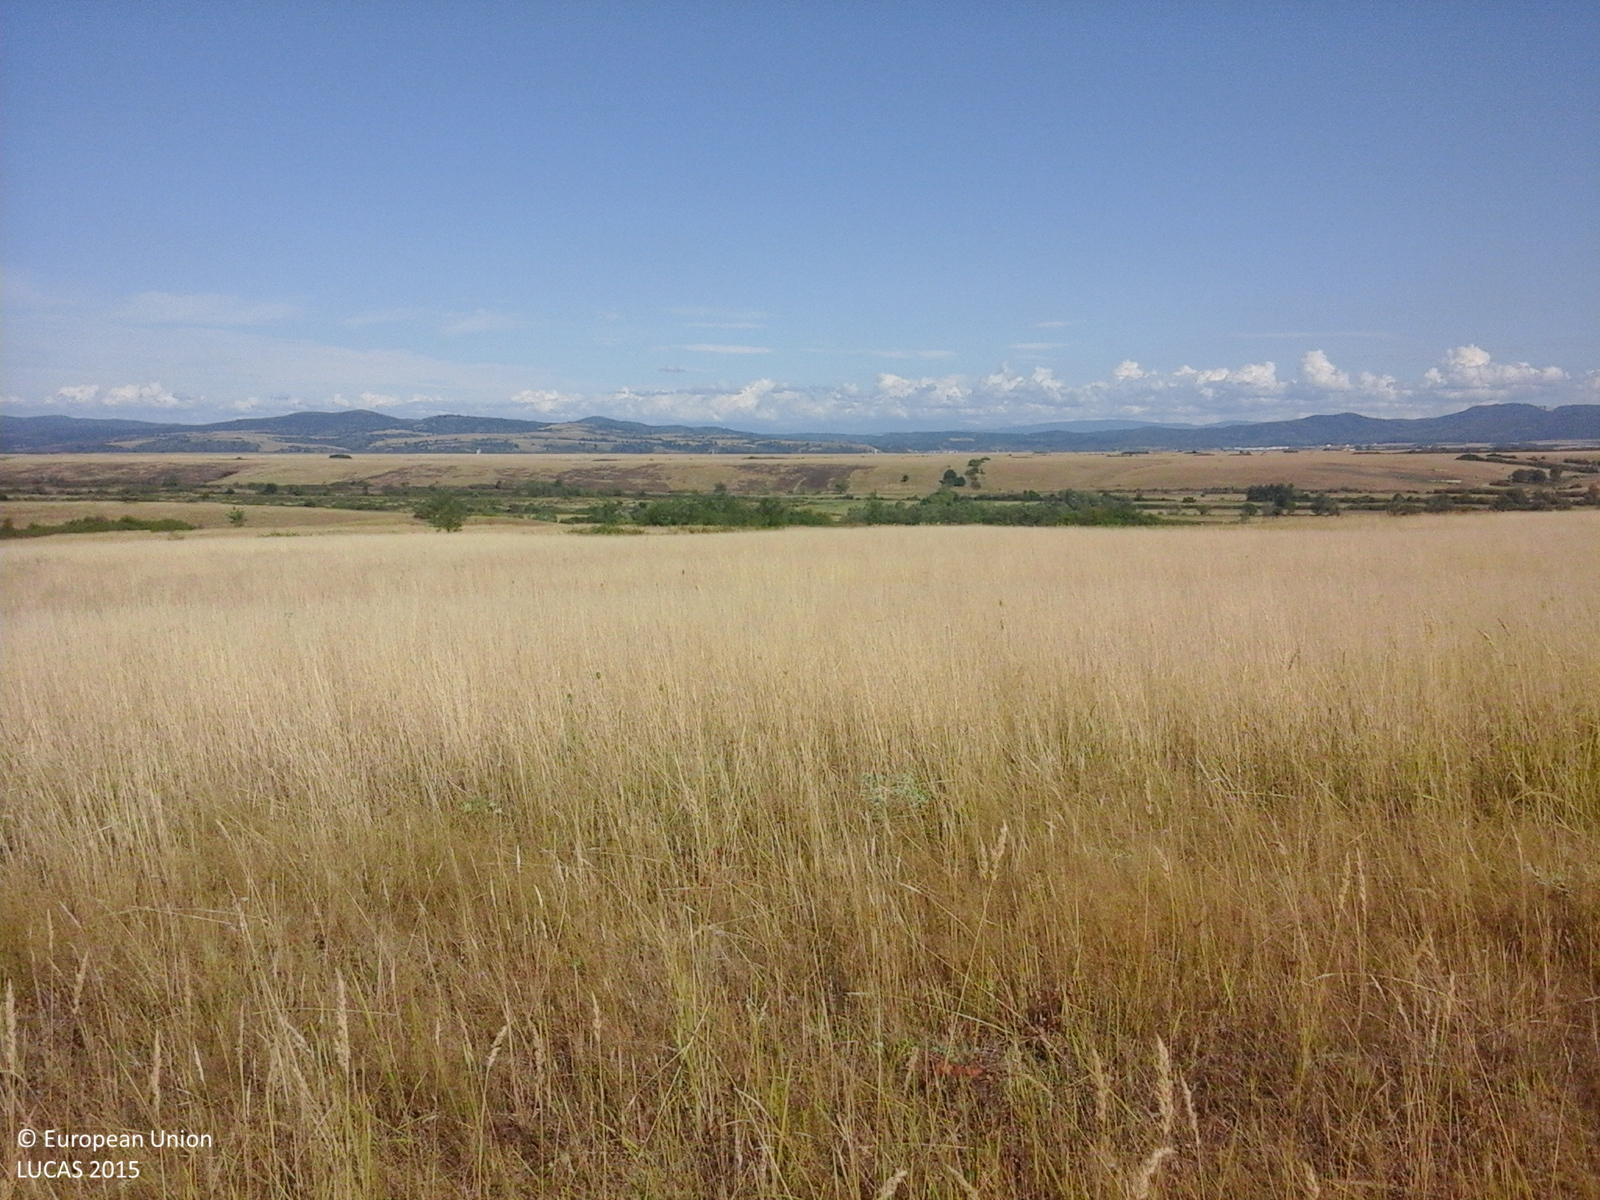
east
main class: Grassland
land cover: Grassland without tree/shrub cover
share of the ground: > 75 %
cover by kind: herbaceous plants 100 %
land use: Agriculture (excluding fallow land and kitchen gardens)
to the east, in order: Grassland without tree/shrub cover; Shrubland with sparse tree cover; Grassland without tree/shrub cover
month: August
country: RO
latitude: 45.3912
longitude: 21.5923
